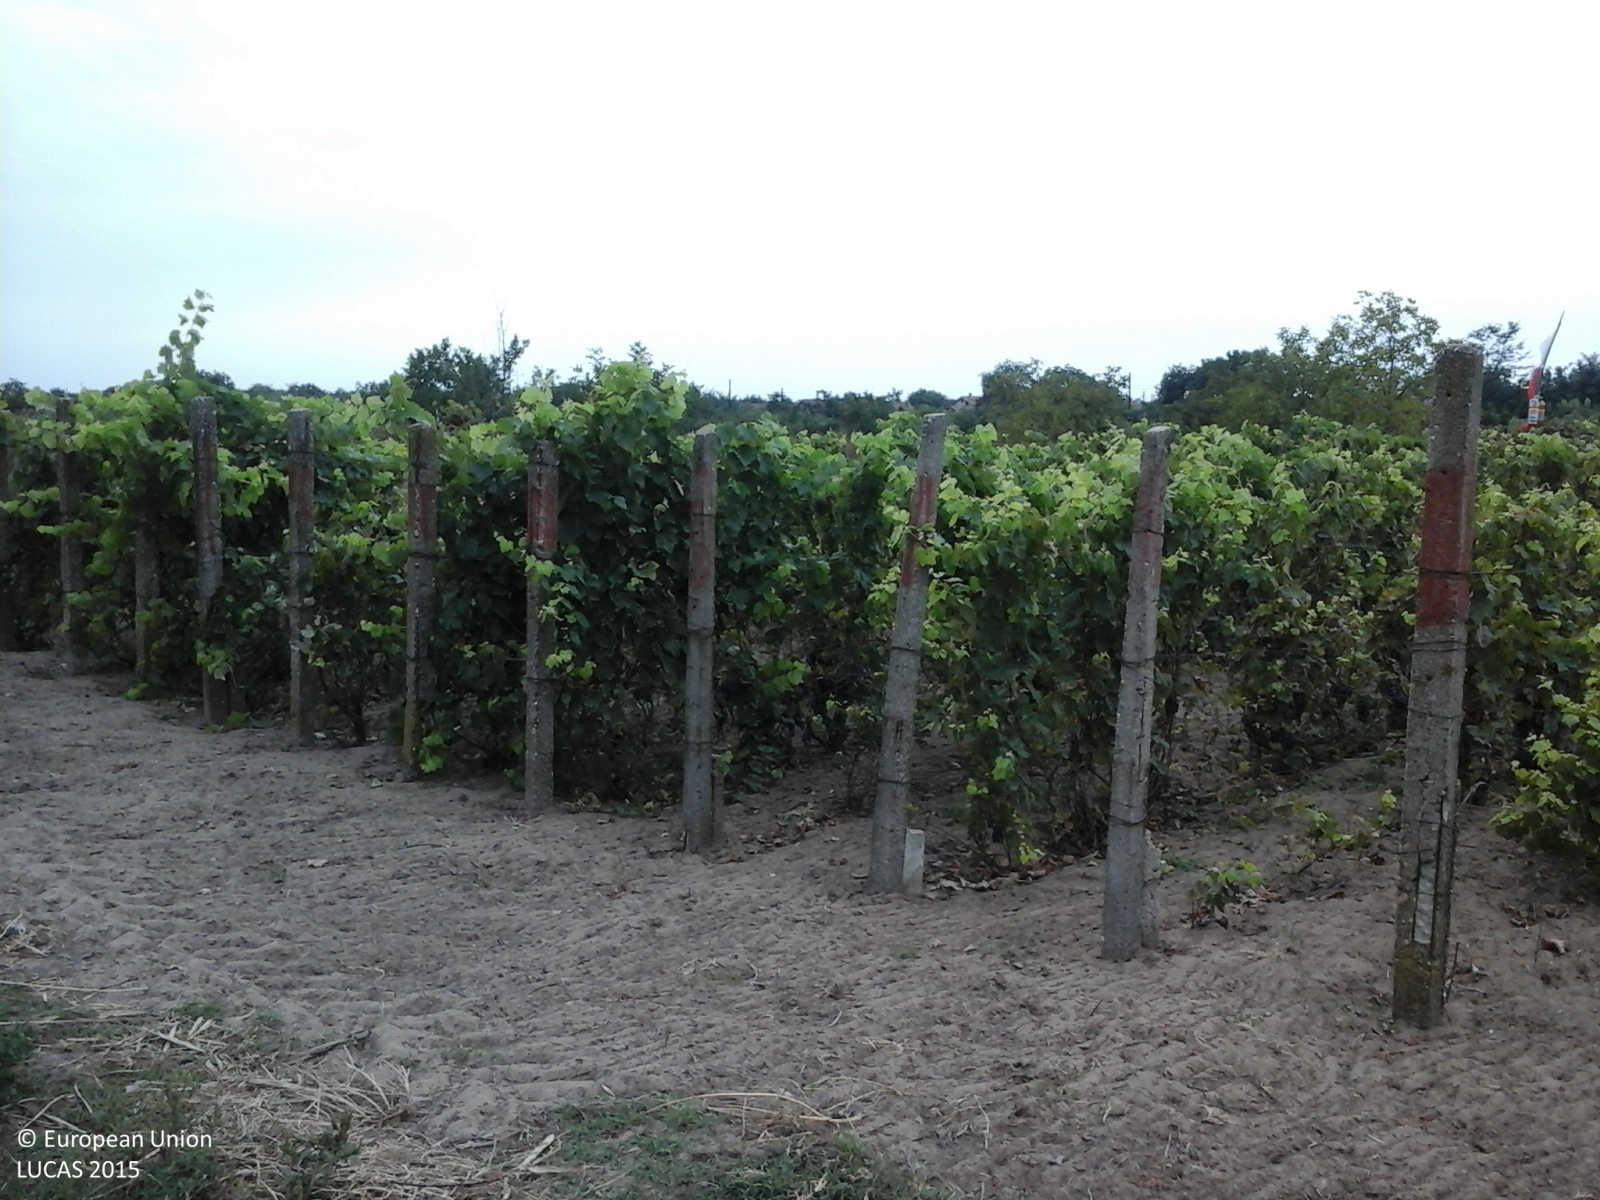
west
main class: Cropland
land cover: Vineyards
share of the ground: > 75 %
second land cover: Spontaneously vegetated surfaces
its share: > 75 %
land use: Agriculture (excluding fallow land and kitchen gardens)
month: September
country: RO
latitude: 47.5153
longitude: 22.1221
